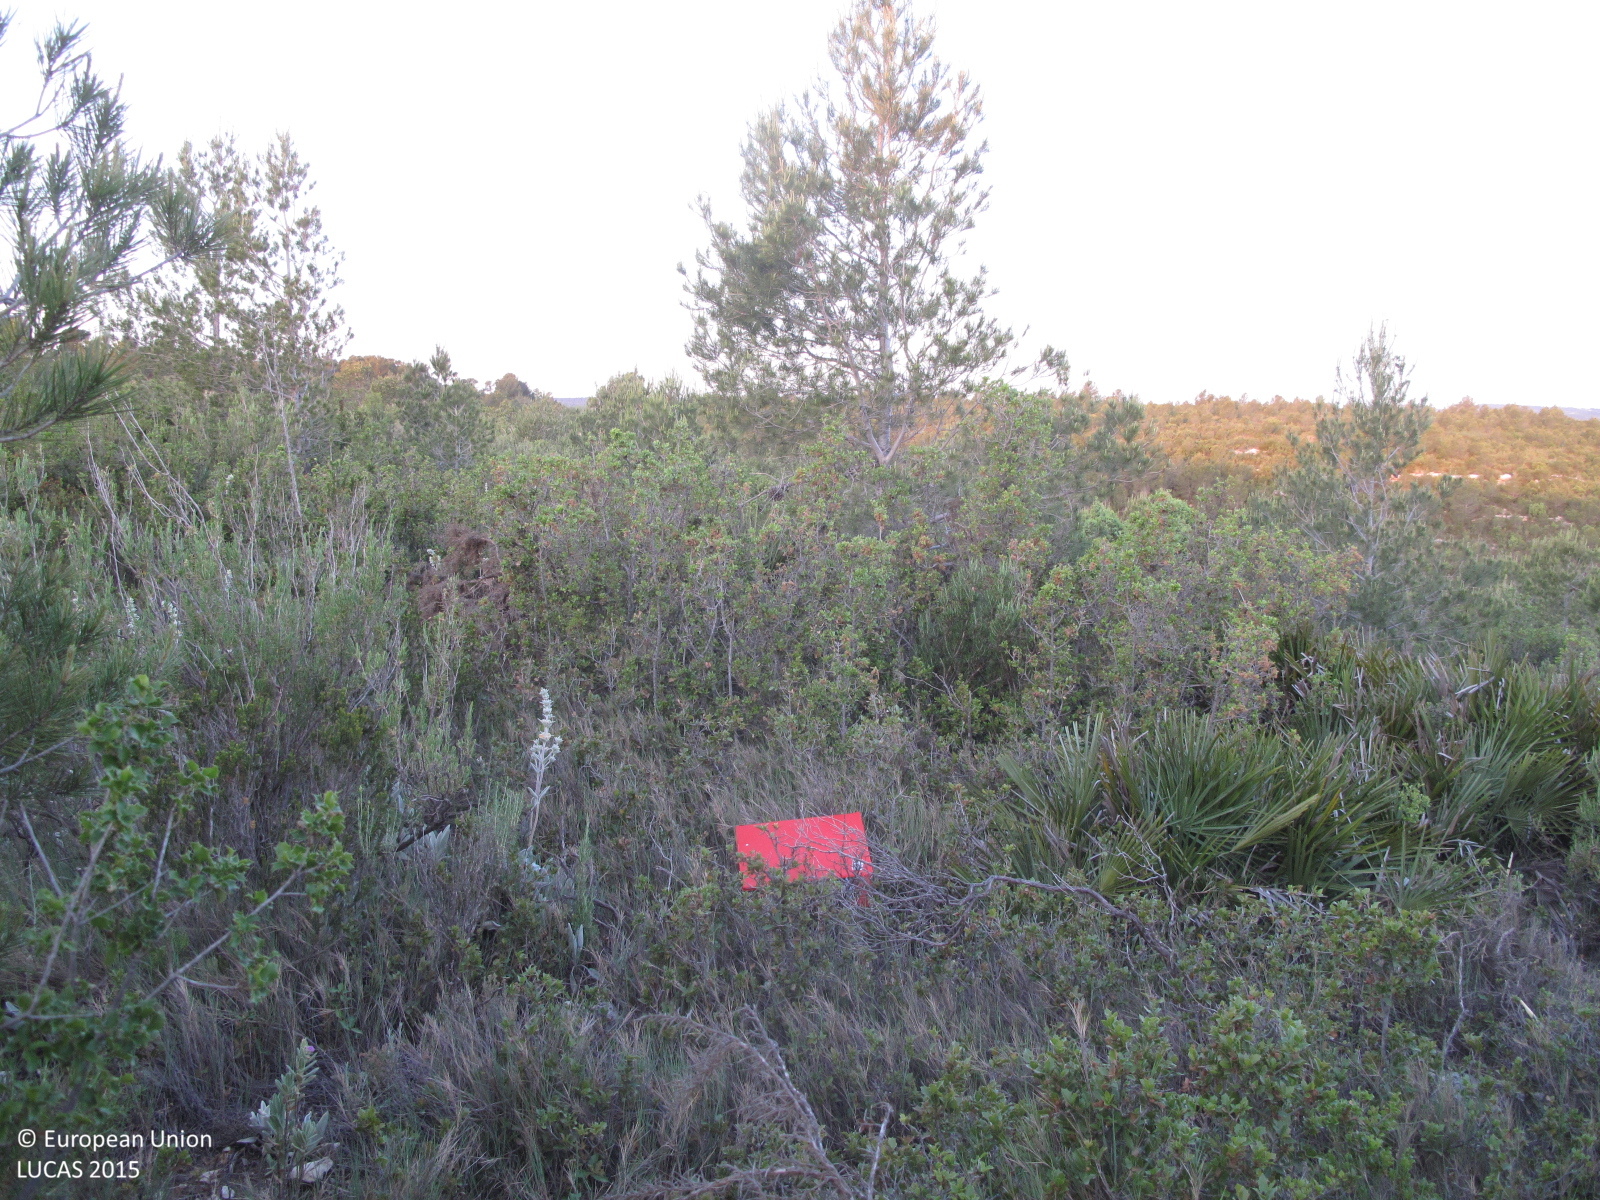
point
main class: Woodland
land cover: Pine dominated coniferous woodland
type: coniferous forest of the mediterranean region
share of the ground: 25 - 50 %
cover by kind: coniferous forest trees 40 %, shrubs 20 %, herbaceous plants 20 %, consolidated bare surface 20 %
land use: Semi-natural and natural areas not in use
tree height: < 5 m
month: May
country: ES
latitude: 39.0491
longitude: -0.7983
